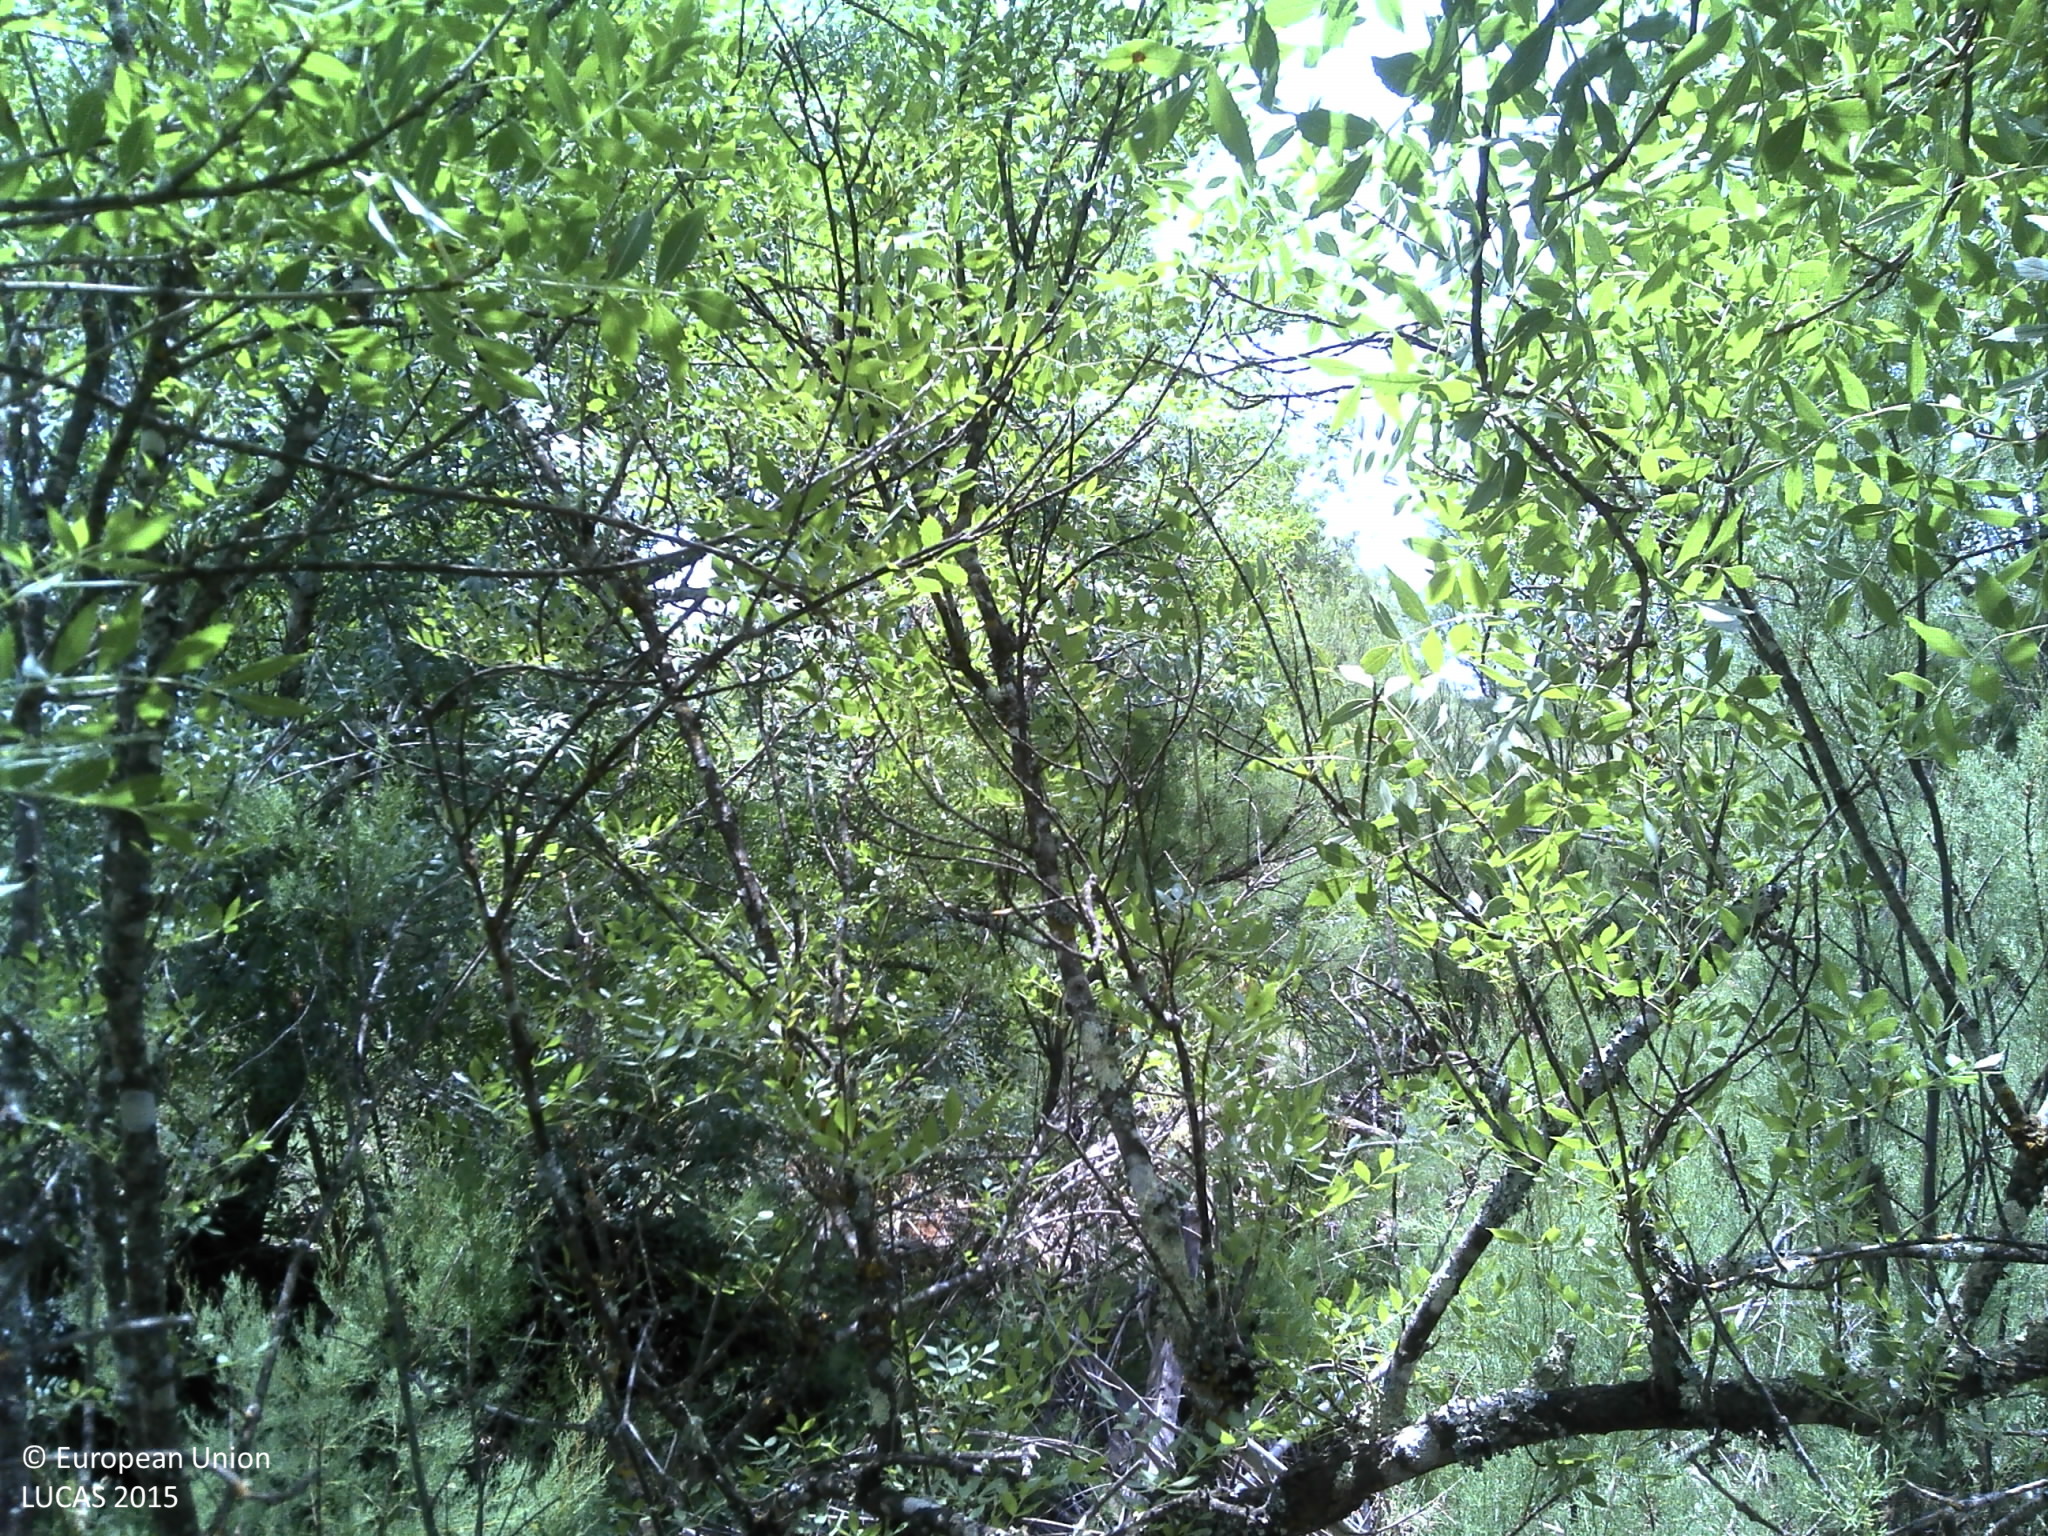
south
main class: Woodland
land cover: Broadleaved woodland
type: floodplain forest
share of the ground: 50 - 75 %
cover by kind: broadleaved forest trees 50 %, shrubs 25 %, unconsolidated bare surface 15 %, herbaceous plants 10 %
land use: Semi-natural and natural areas not in use
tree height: > 5 m
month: May
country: PT
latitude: 38.0342
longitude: -8.3722
